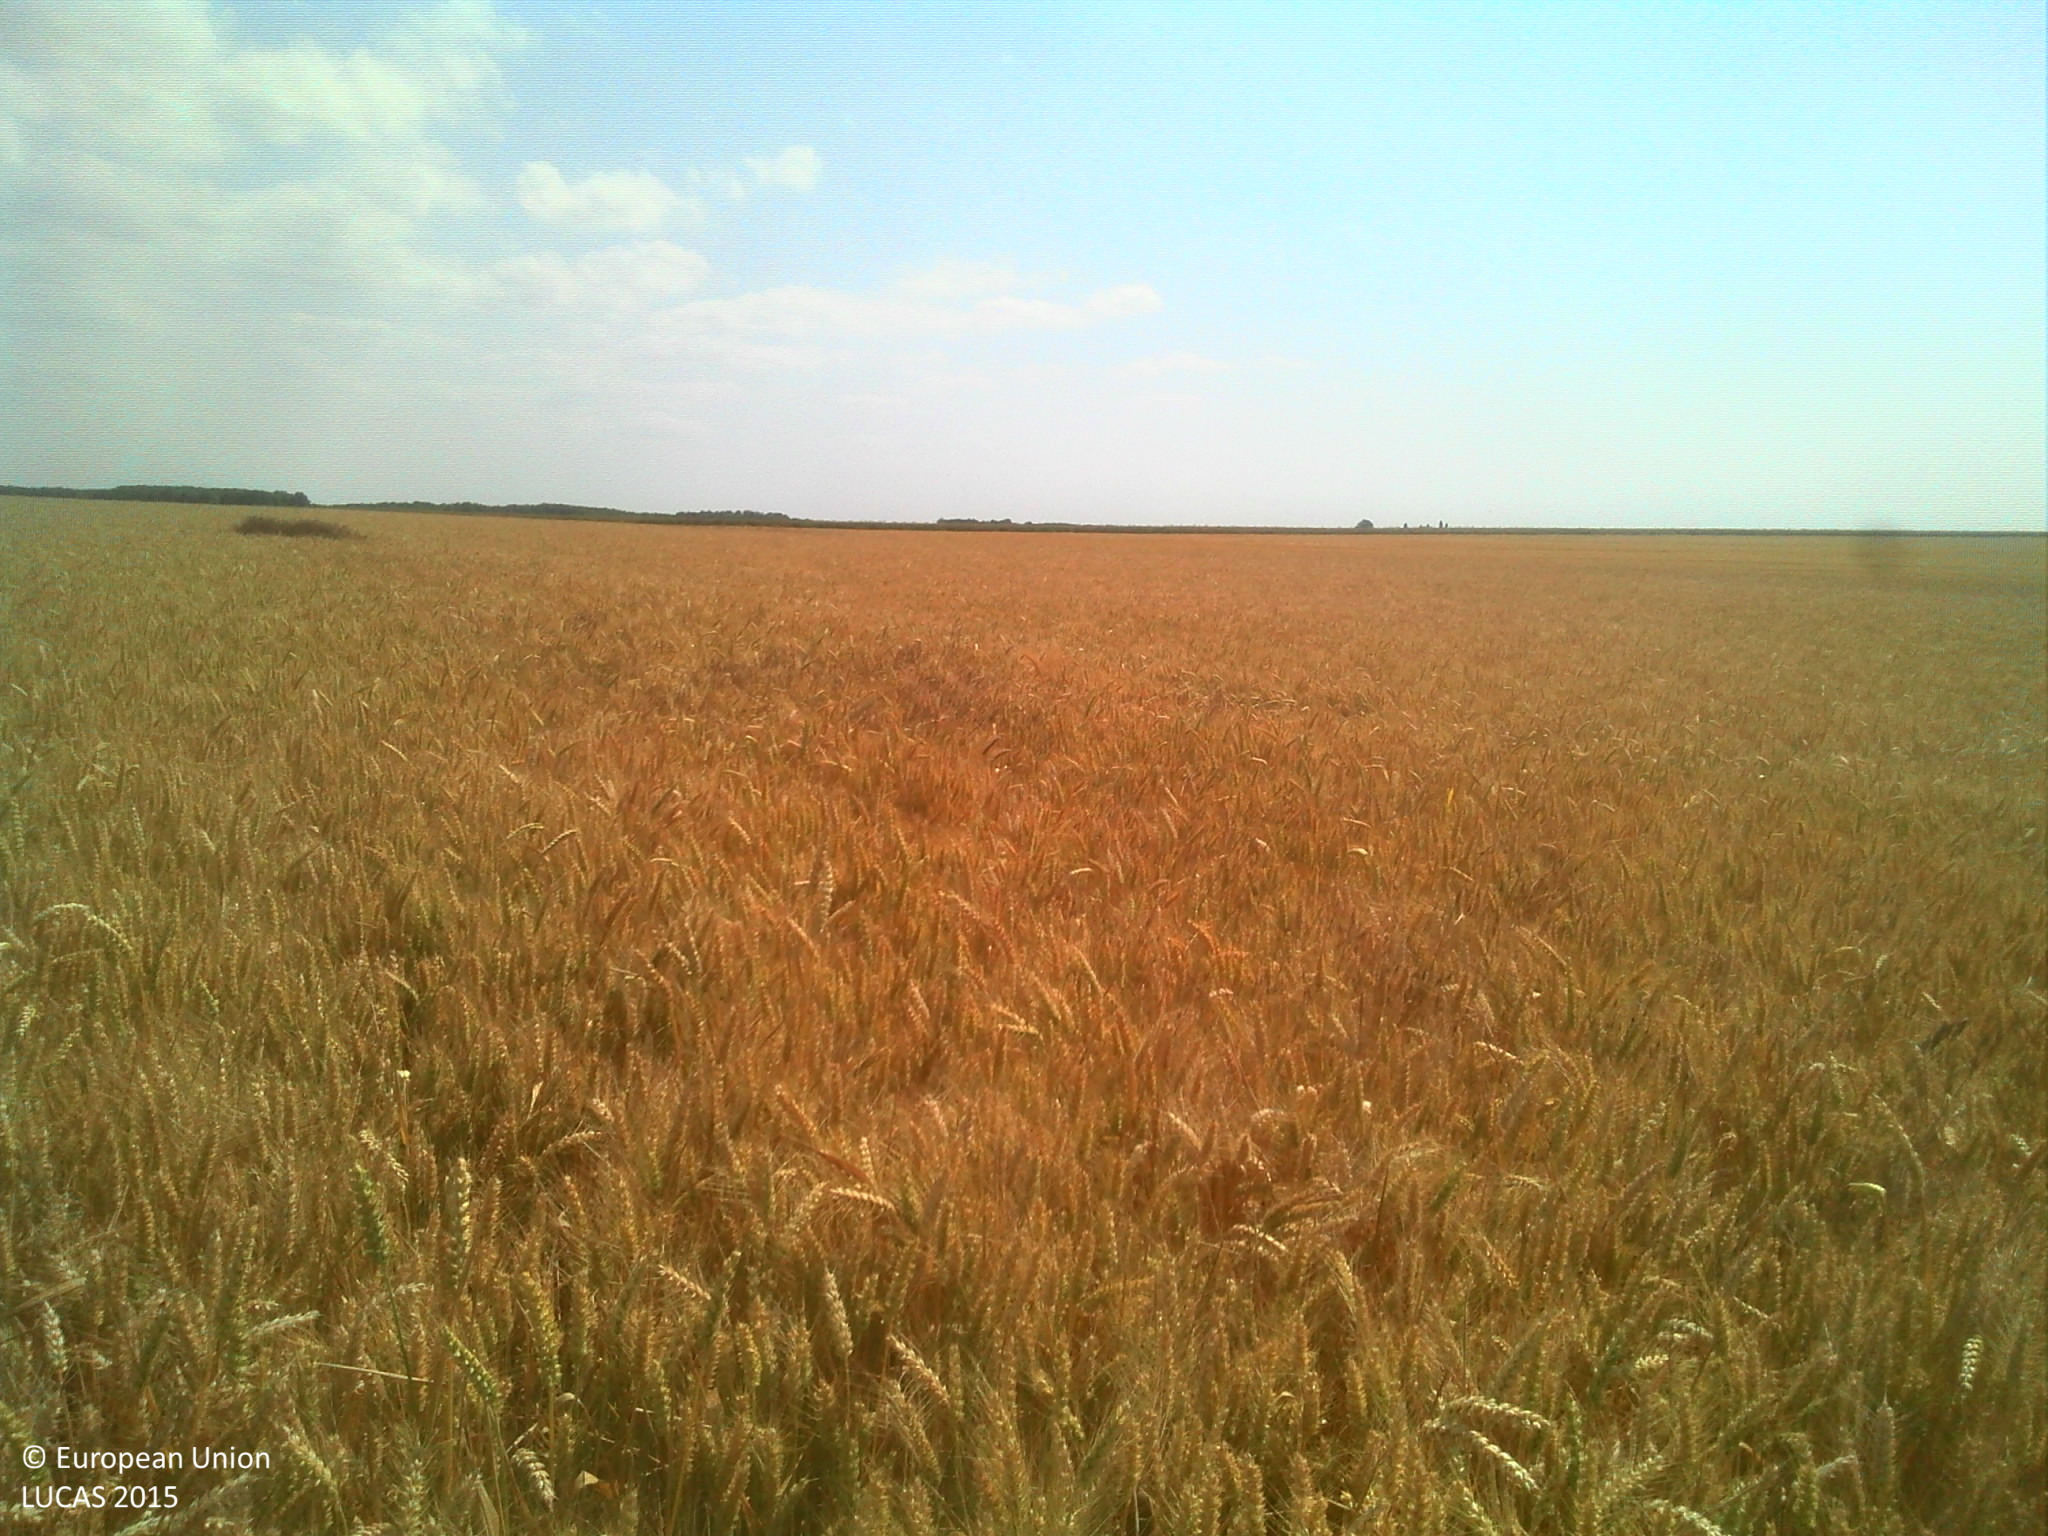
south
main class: Cropland
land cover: Common wheat
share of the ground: > 75 %
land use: Agriculture (excluding fallow land and kitchen gardens)
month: July
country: FR
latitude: 48.7563
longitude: 1.1795
